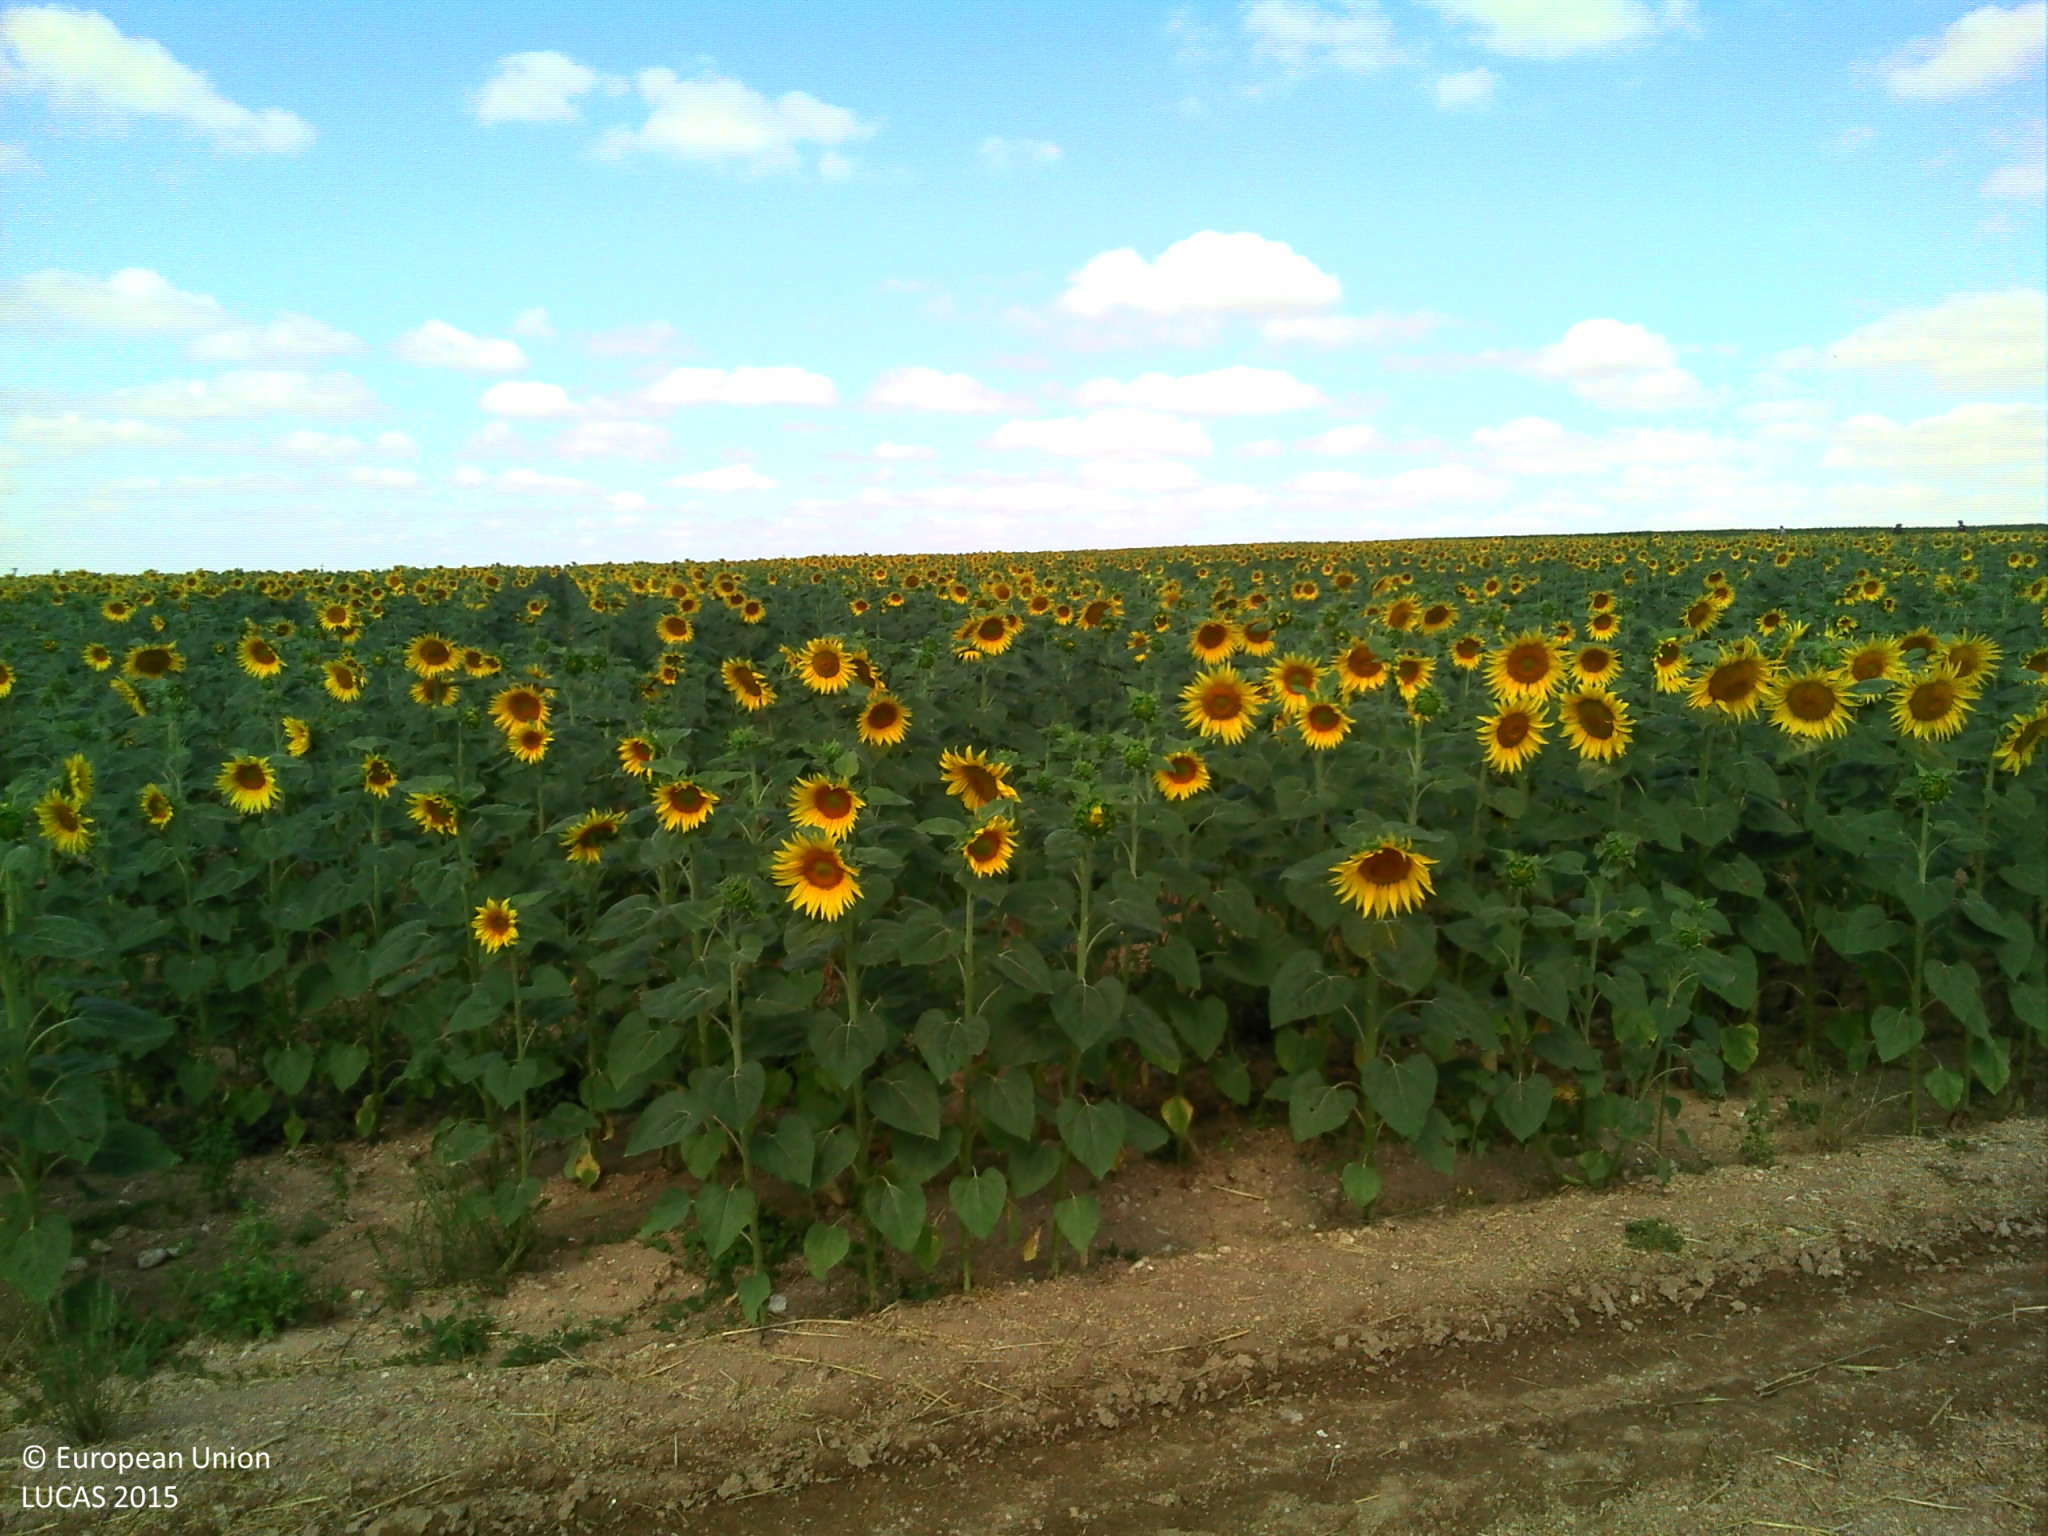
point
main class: Cropland
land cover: Sunflower
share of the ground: > 75 %
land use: Agriculture (excluding fallow land and kitchen gardens)
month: July
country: FR
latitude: 46.6325
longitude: 0.2751
